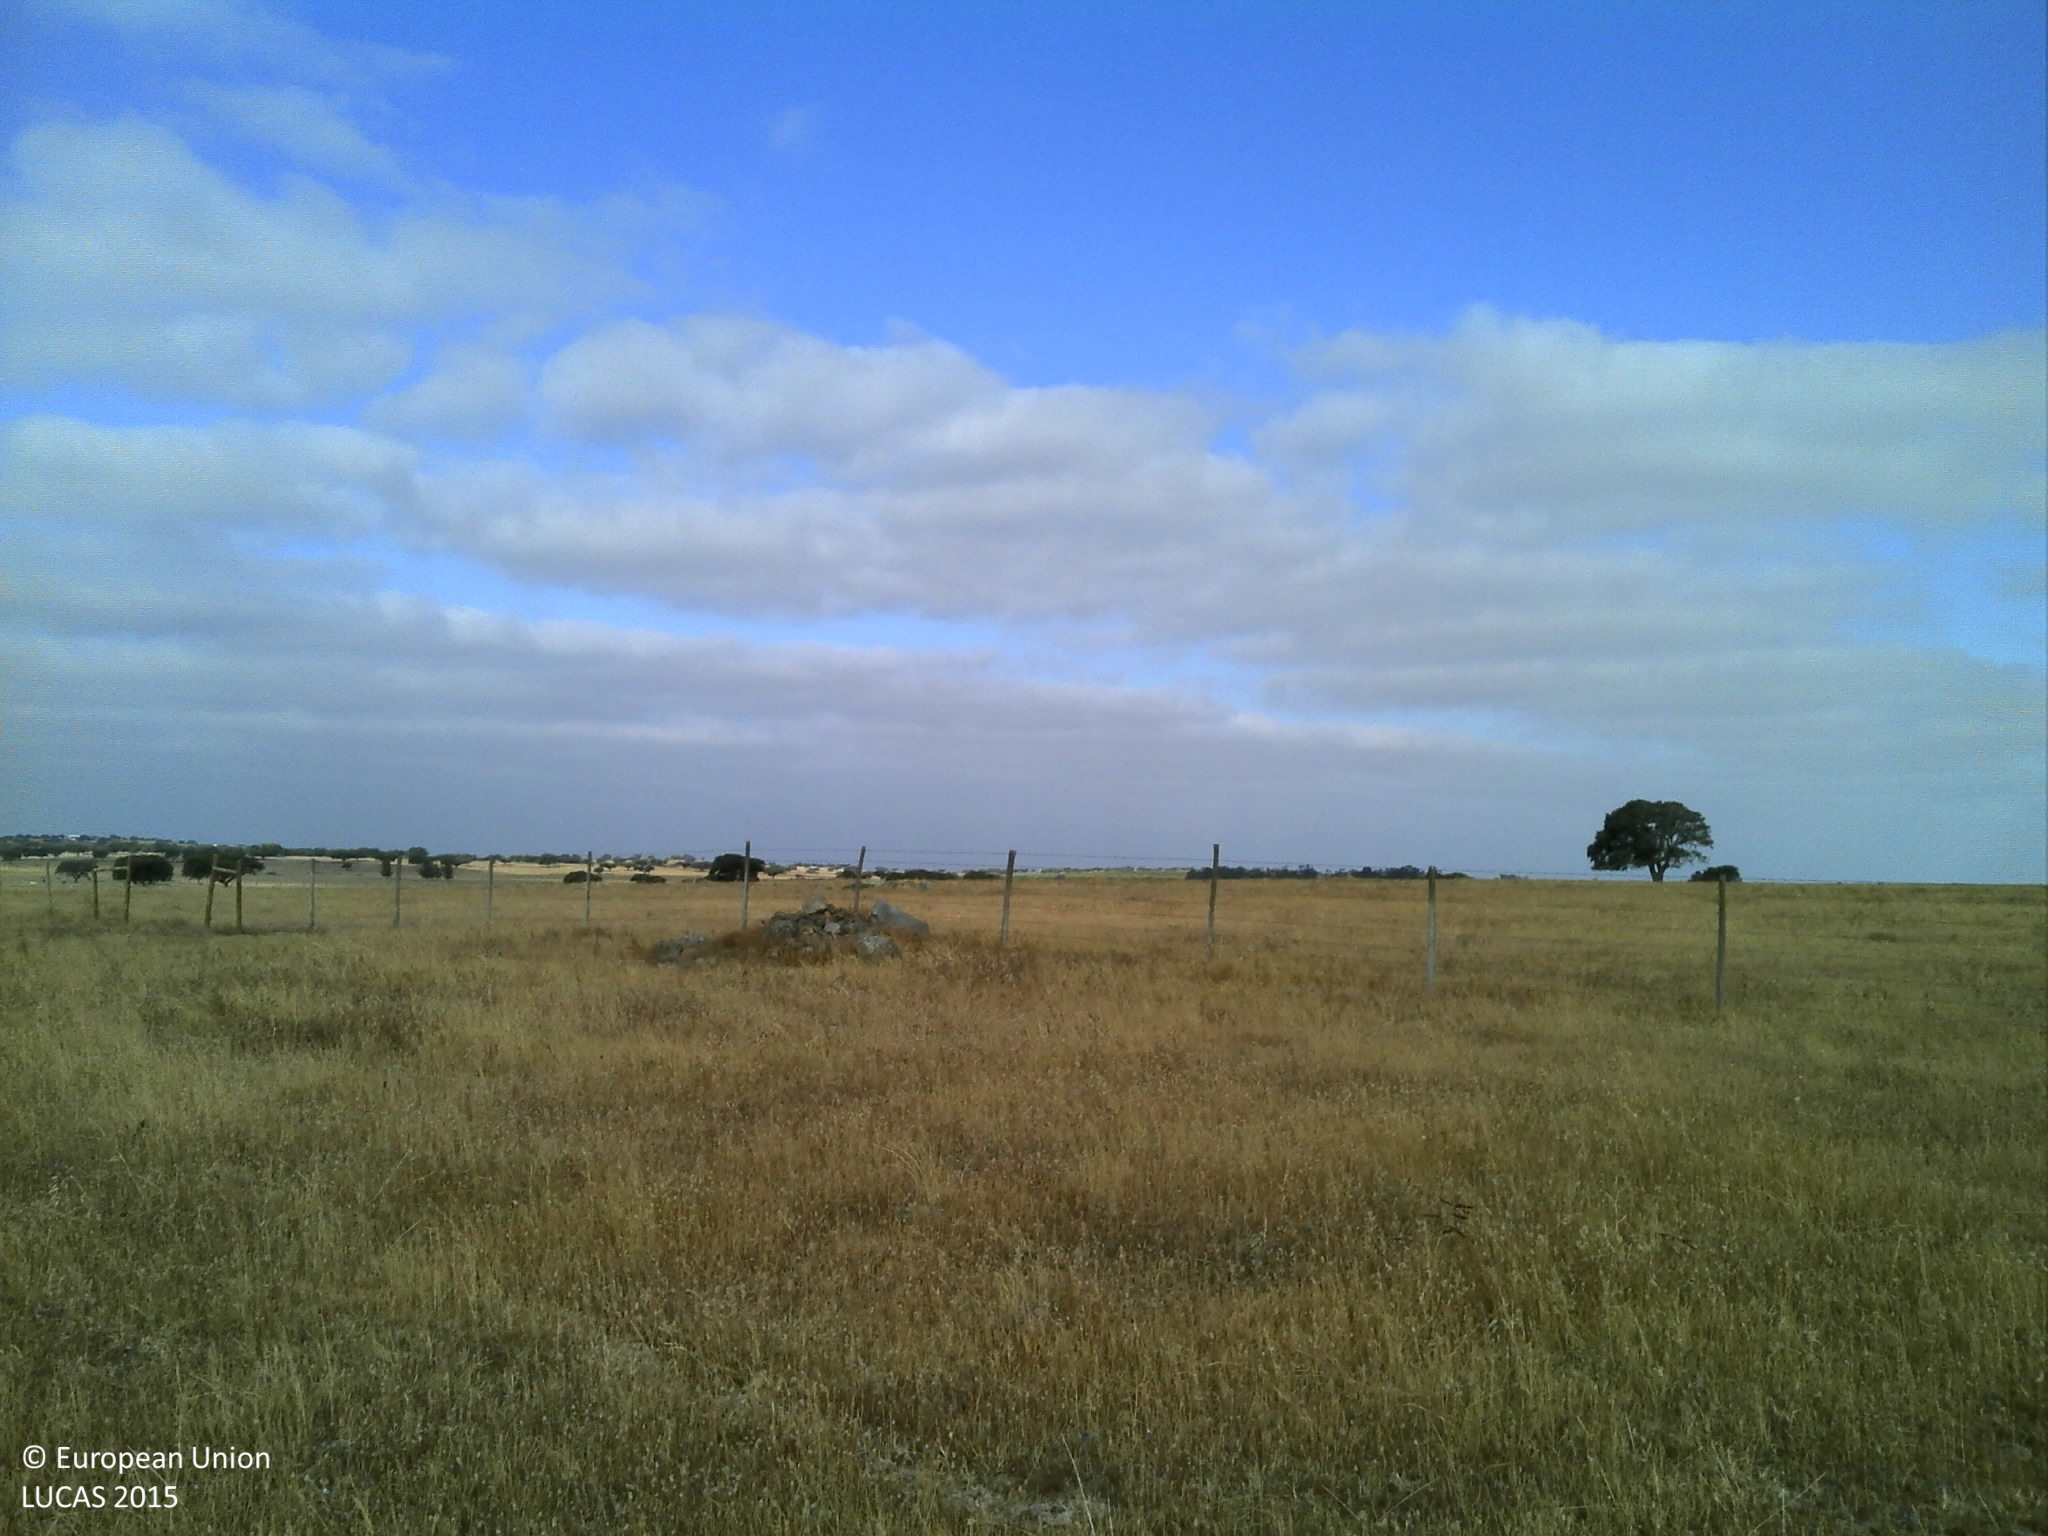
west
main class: Grassland
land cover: Grassland without tree/shrub cover
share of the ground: > 75 %
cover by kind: herbaceous plants 80 %, unconsolidated bare surface 20 %
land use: Agriculture (excluding fallow land and kitchen gardens)
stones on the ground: < 10 %
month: June
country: PT
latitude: 38.1769
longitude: -7.9202
